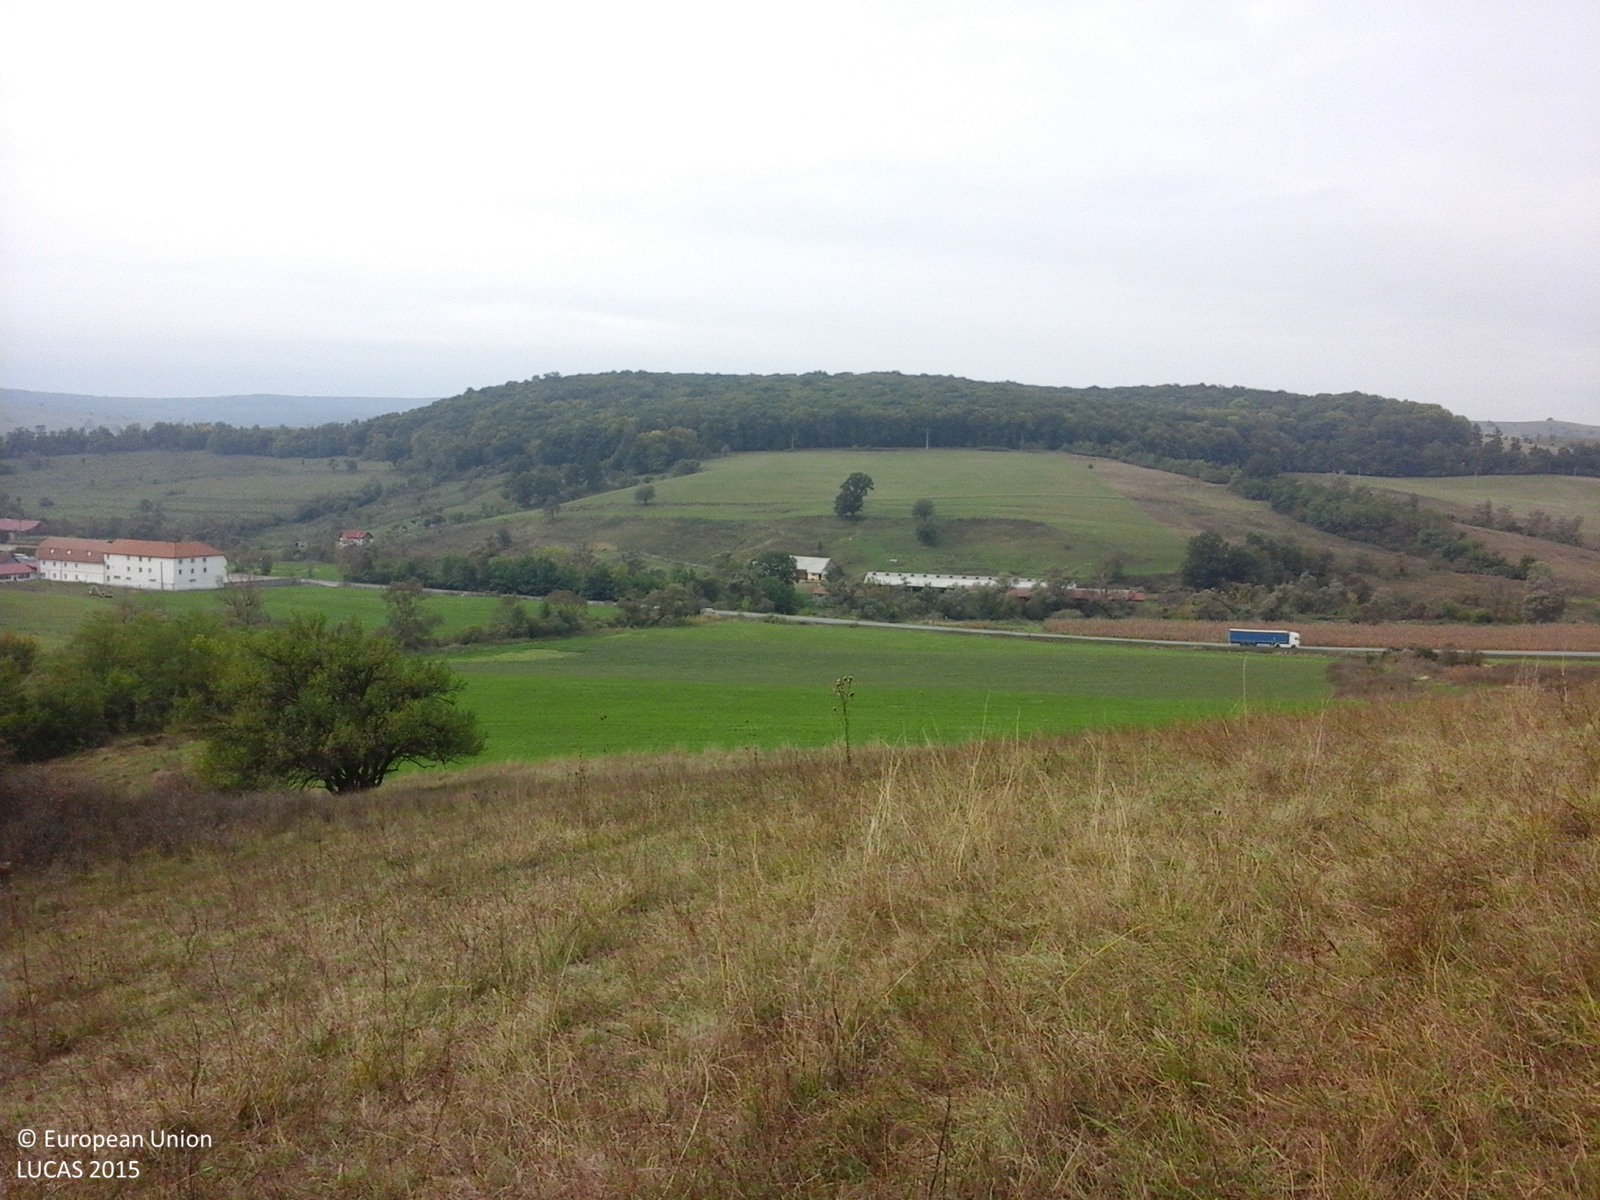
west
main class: Grassland
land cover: Spontaneously vegetated surfaces
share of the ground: > 75 %
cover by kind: herbaceous plants 100 %
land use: Fallow land
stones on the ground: < 10 %
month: October
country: RO
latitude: 46.0438
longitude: 25.2051
